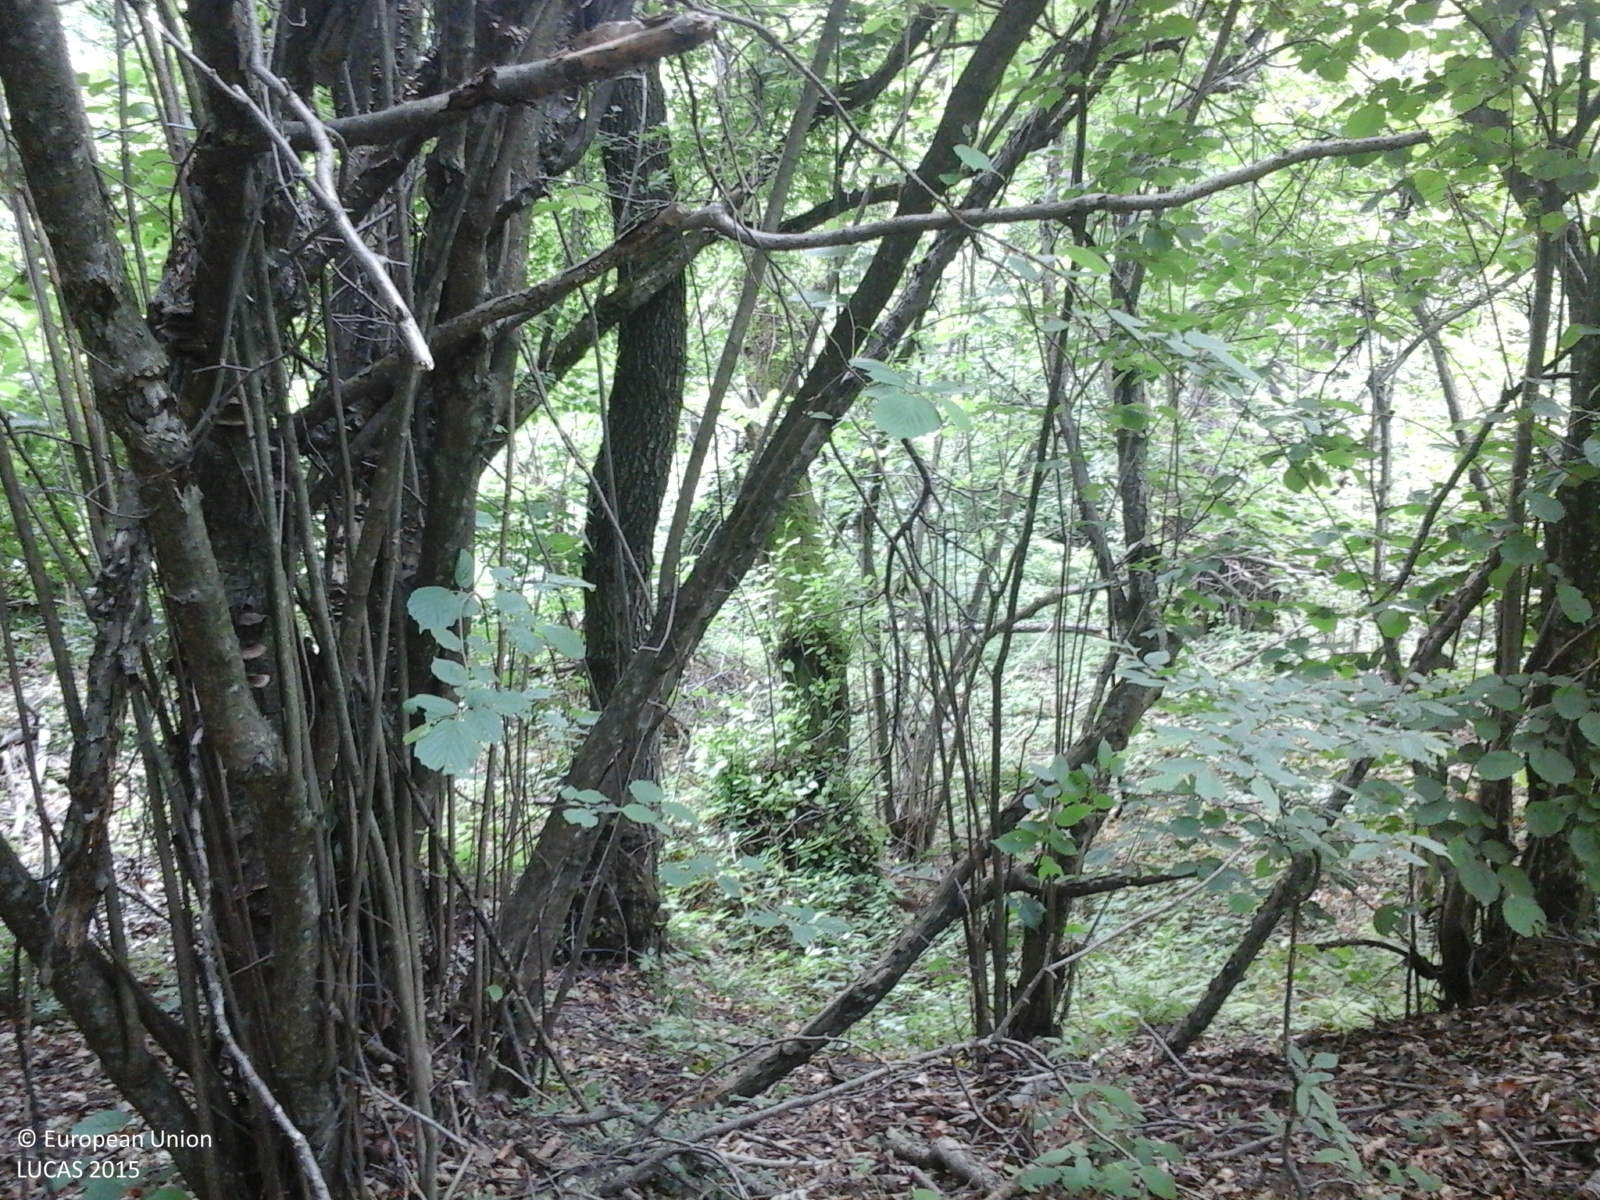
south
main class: Woodland
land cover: Broadleaved woodland
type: beech forest
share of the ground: > 75 %
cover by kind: broadleaved forest trees 100 %
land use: Forestry
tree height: > 5 m
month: May
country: RO
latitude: 45.7968
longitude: 25.2663
